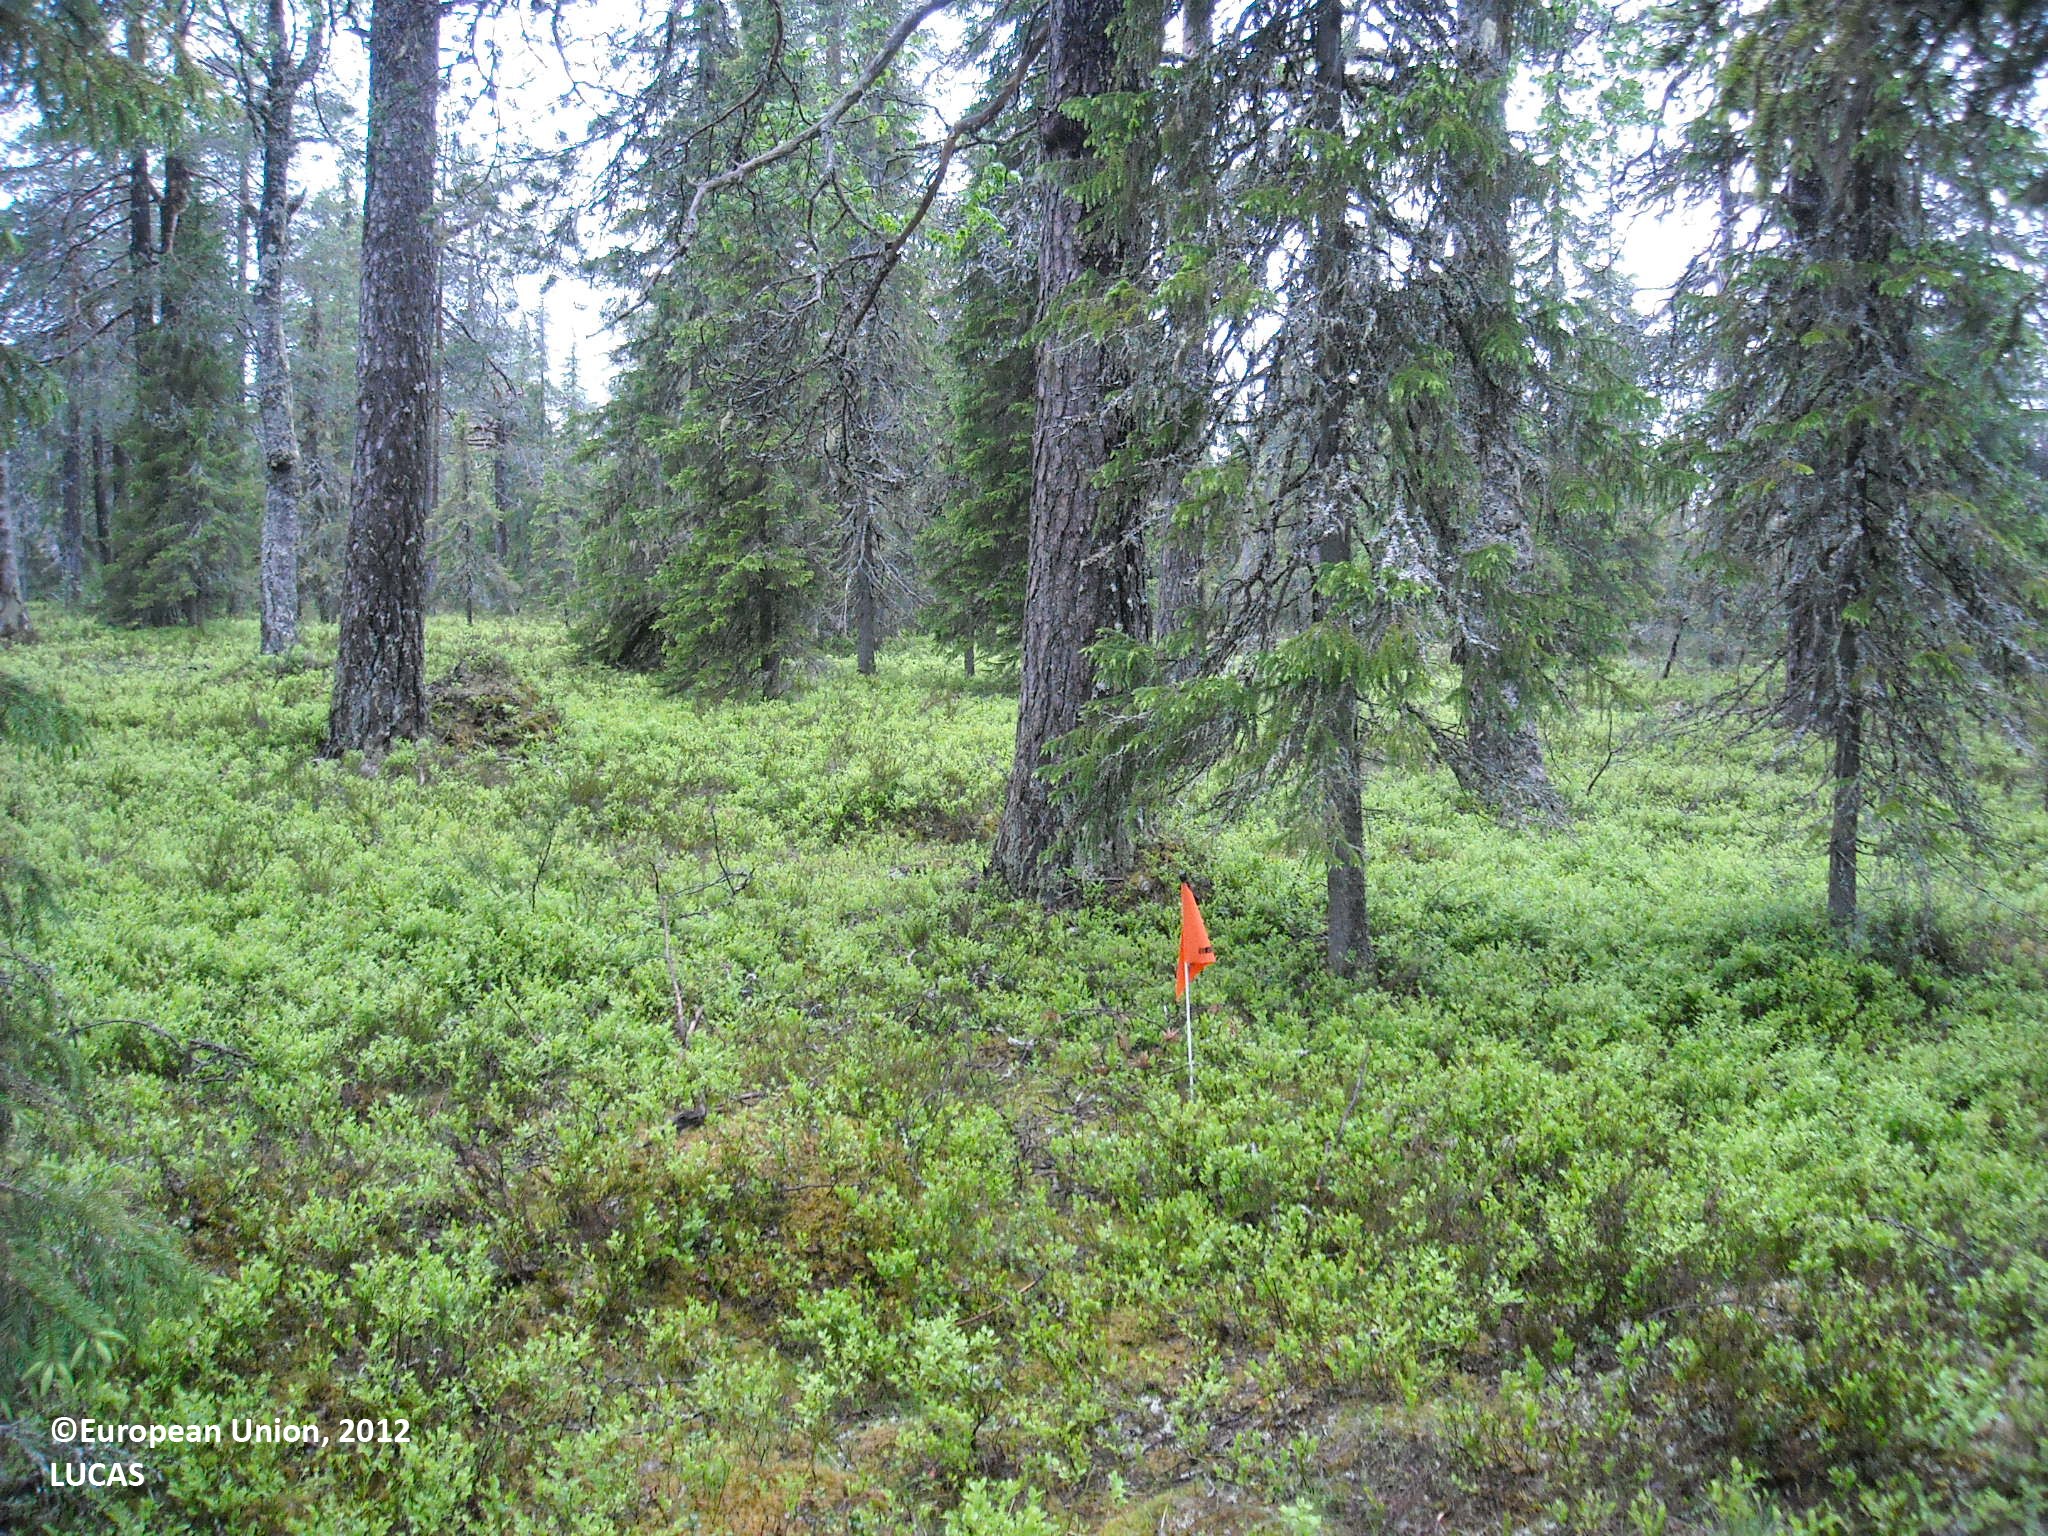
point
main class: Woodland
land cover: Other coniferous woodland
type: boreal forest
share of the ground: > 75 %
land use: Forestry
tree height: > 5 m
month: June
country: FI
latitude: 65.5908
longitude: 27.8569
